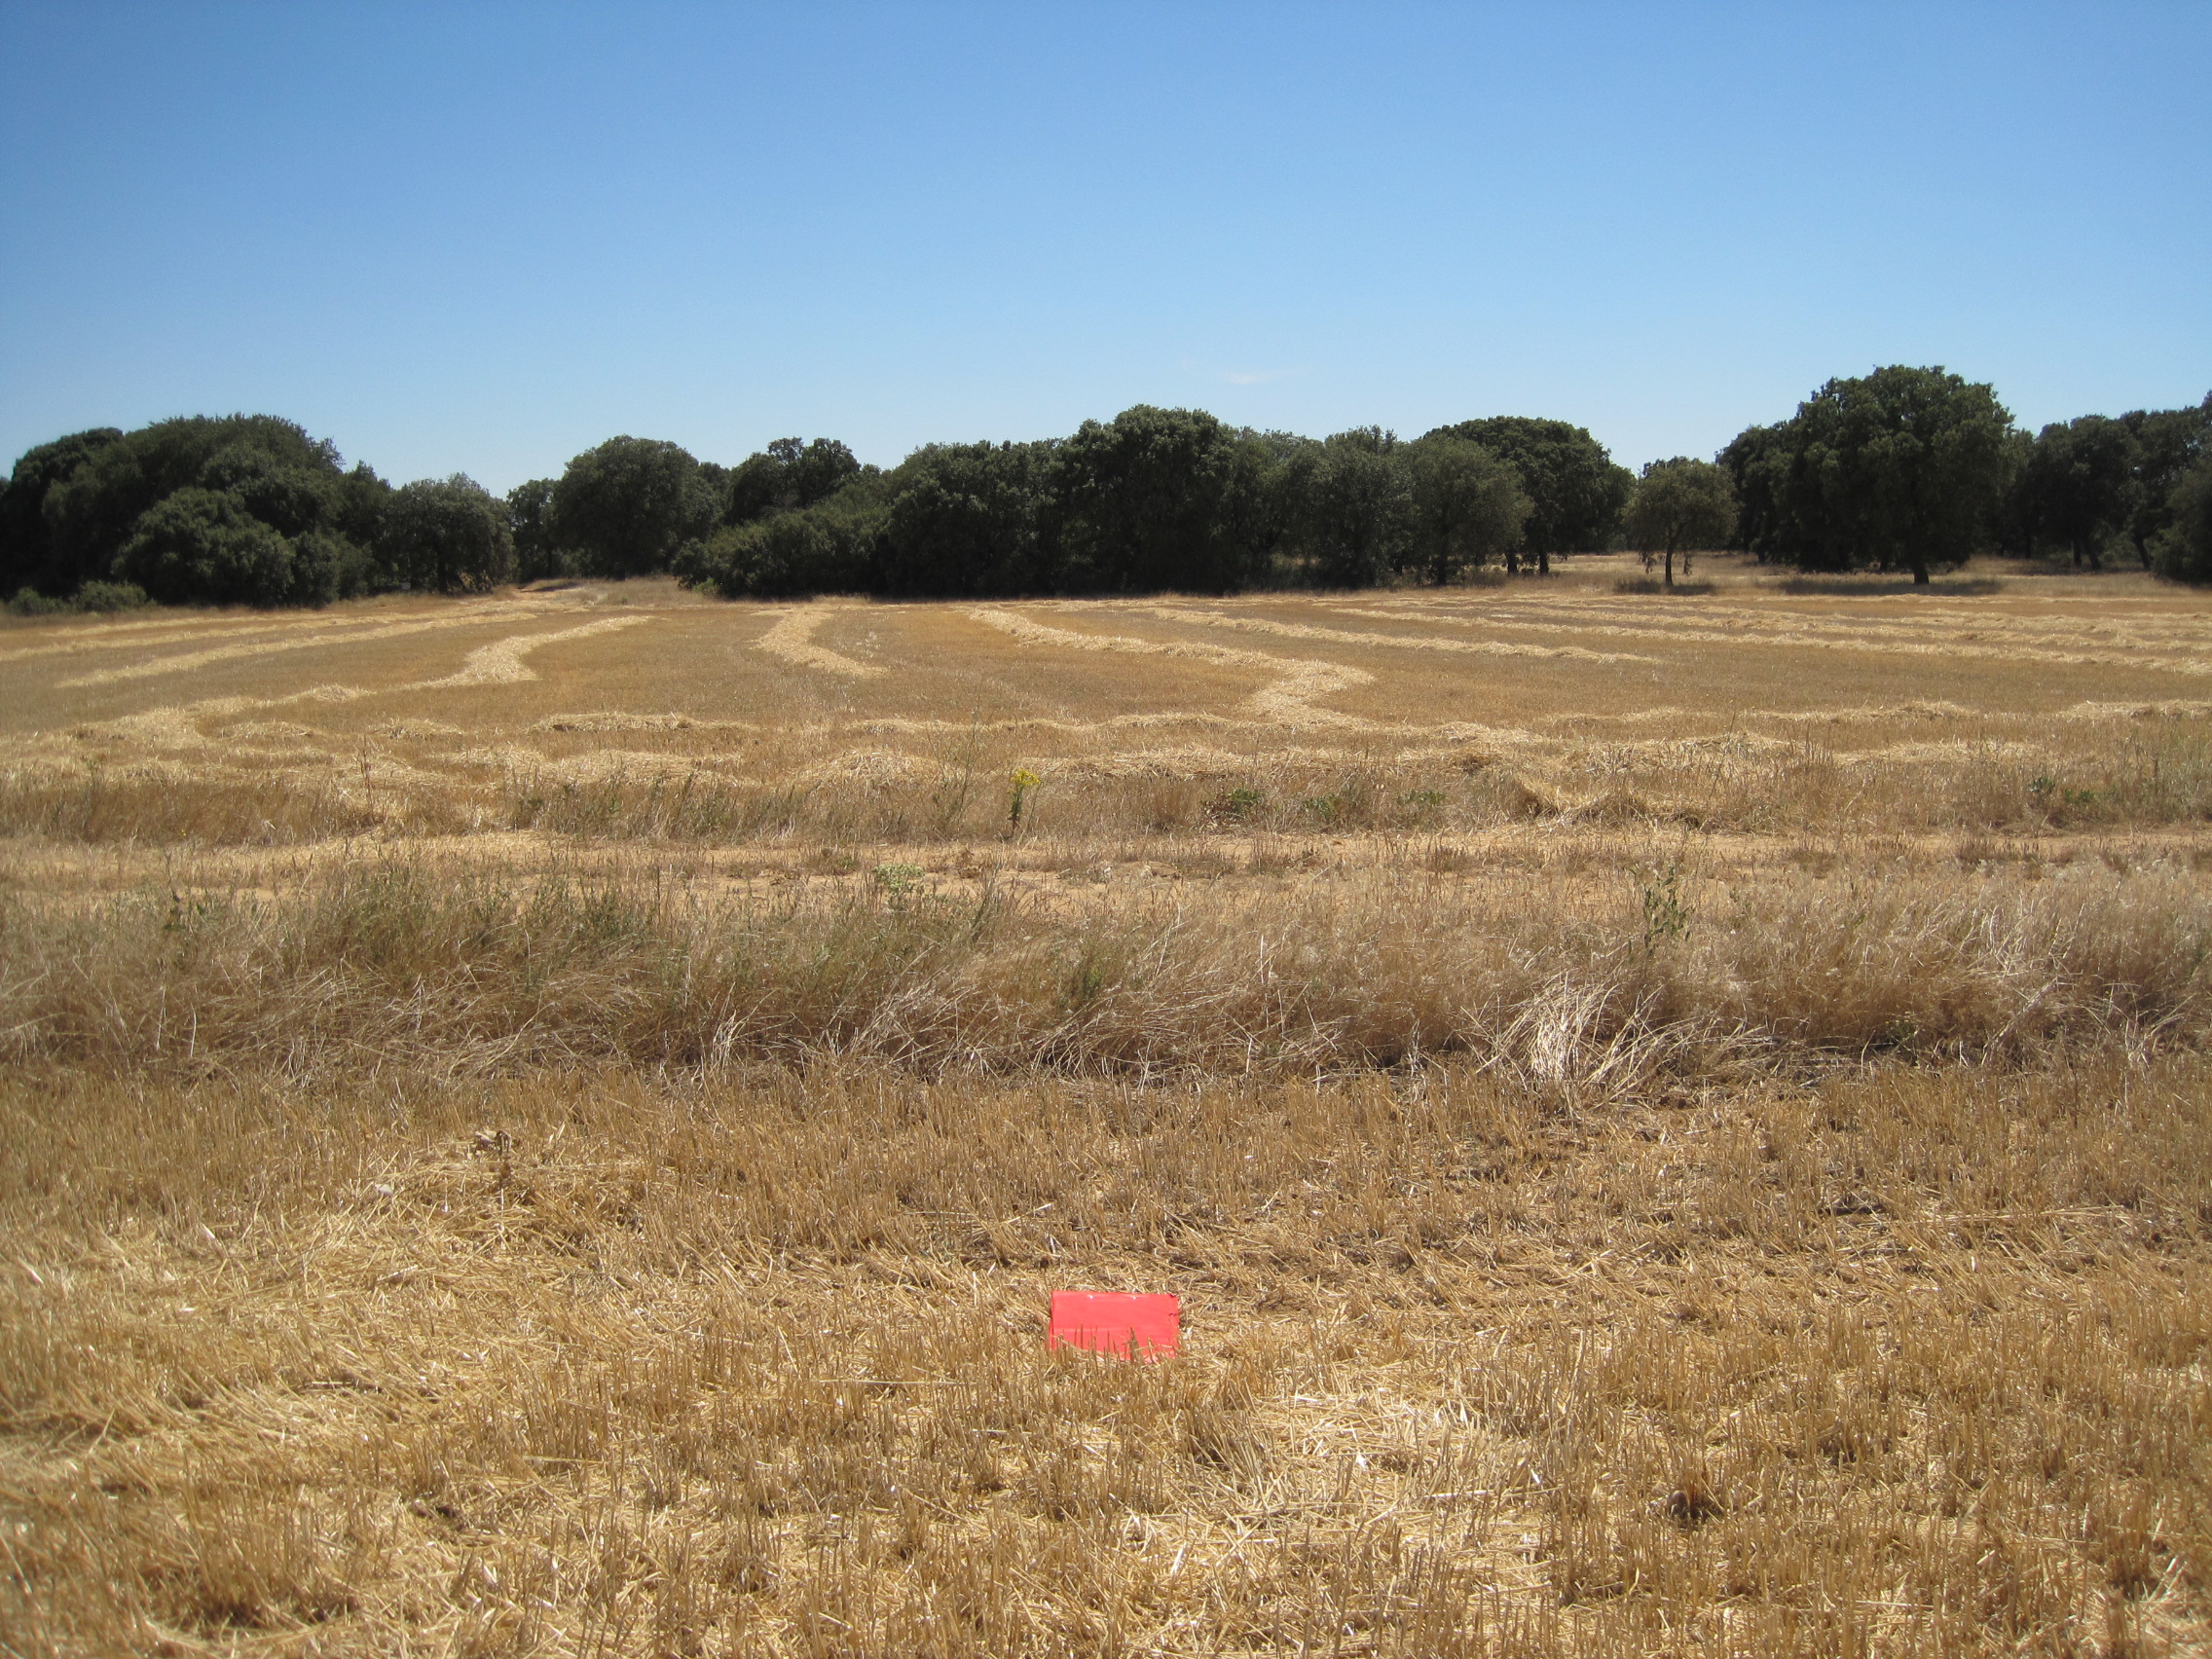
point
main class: Cropland
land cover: Barley
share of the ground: < 10 %
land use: Agriculture (excluding fallow land and kitchen gardens)
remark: Harvested field
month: July
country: ES
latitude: 42.1423
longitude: -5.6658
